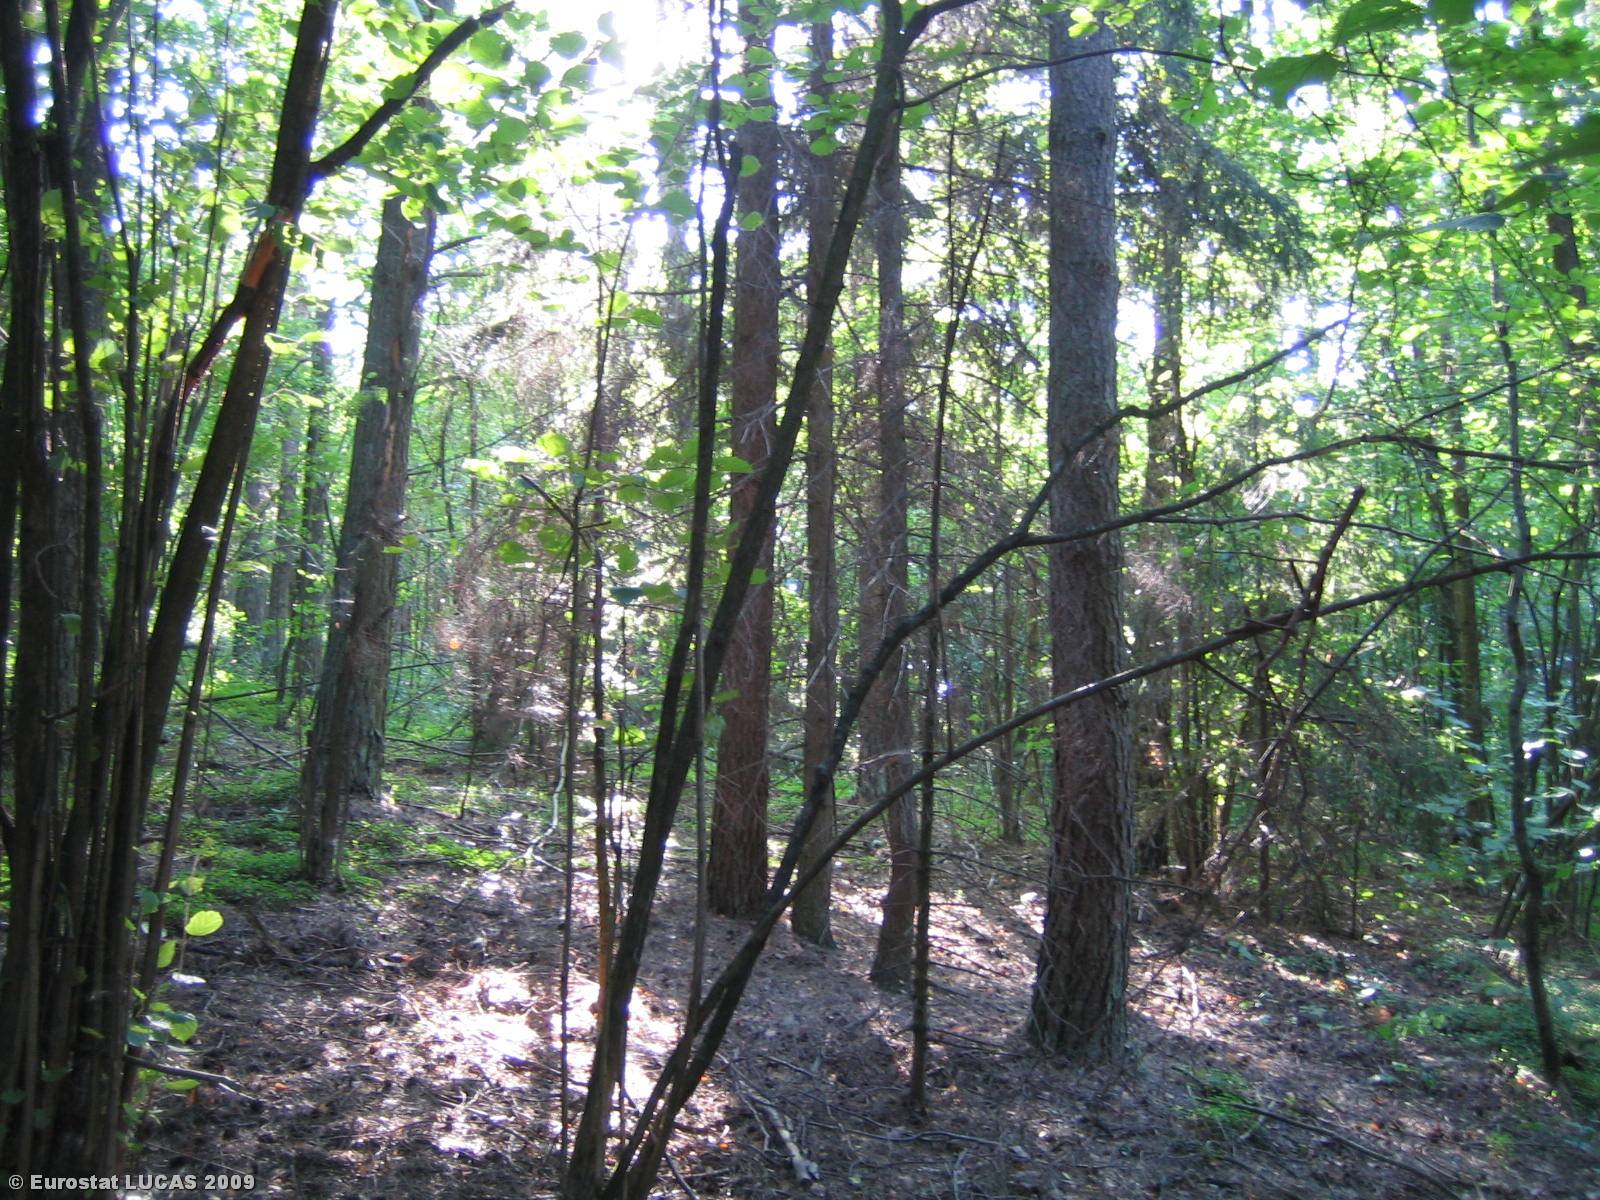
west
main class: Woodland
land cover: Mixed woodland
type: hemiboreal forest and nemoral coniferous forest and mixed broadleaved-coniferous forest
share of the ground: > 75 %
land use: Forestry
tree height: > 5 m
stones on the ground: < 10 %
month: August
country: LT
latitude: 54.8024
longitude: 24.5556
